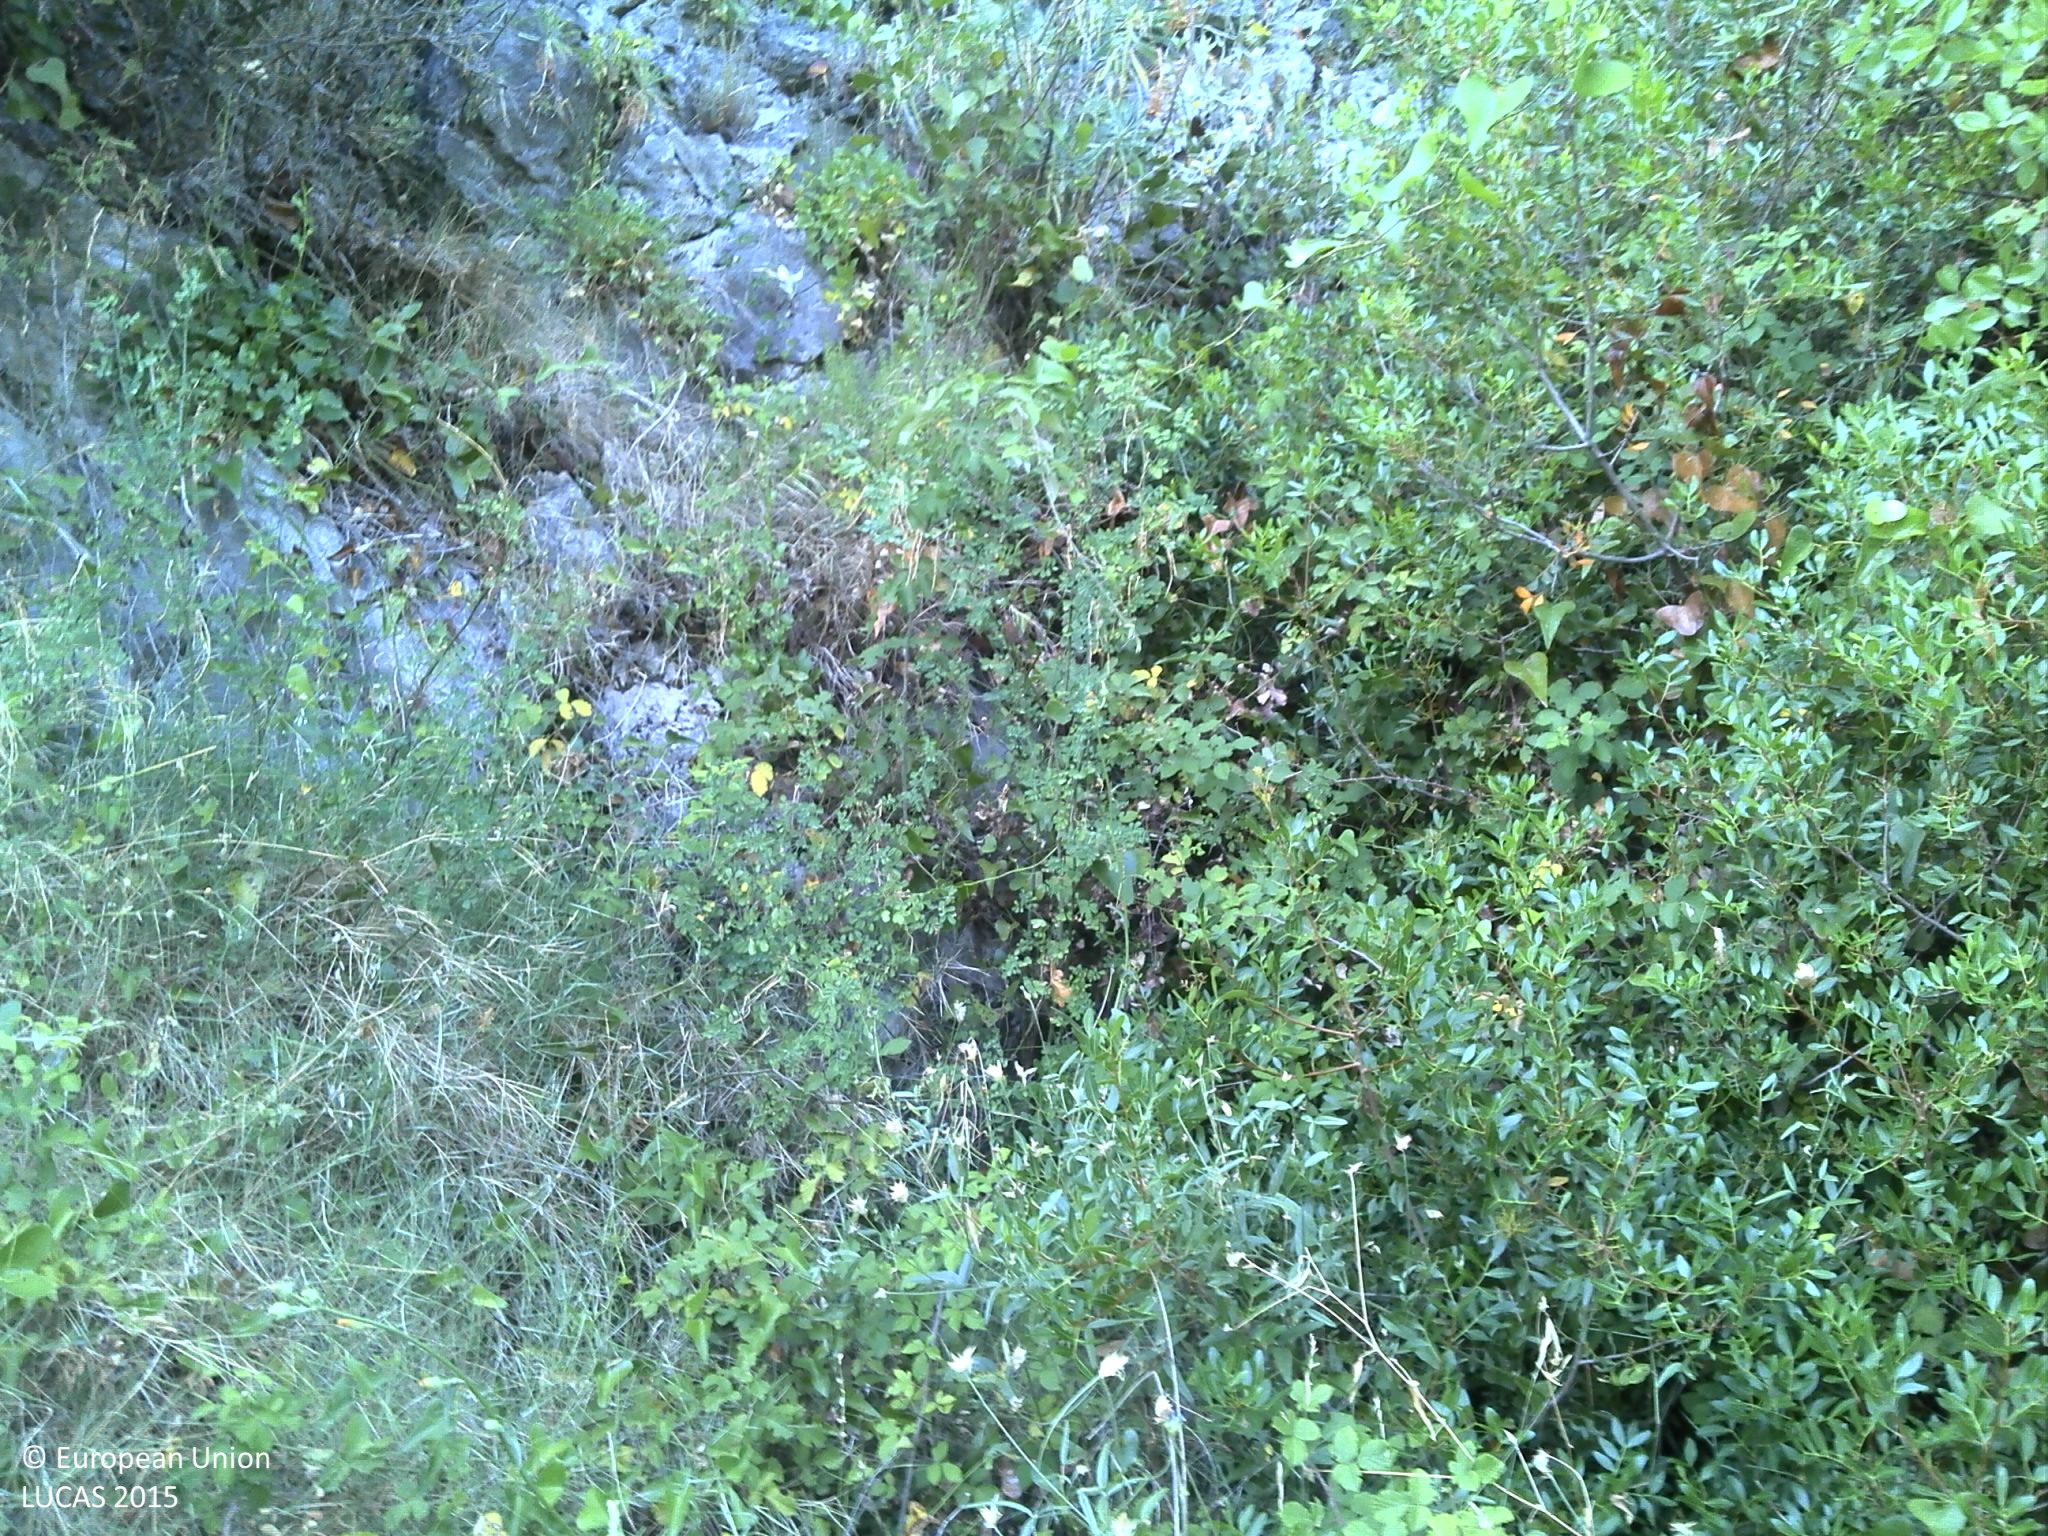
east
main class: Shrubland
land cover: Shrubland with sparse tree cover
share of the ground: 50 - 75 %
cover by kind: shrubs 60 %, herbaceous plants 15 %, unconsolidated bare surface 15 %, broadleaved forest trees 5 %, consolidated bare surface 5 %
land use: Semi-natural and natural areas not in use
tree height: < 5 m
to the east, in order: Shrubland with sparse tree cover; Dry stone walls; Olive groves; Spontaneously vegetated surfaces; Dry stone walls; Rock outcrops; Olive groves; Ditches and canals; Spontaneously vegetated surfaces; Ditches and canals; Shrubland with sparse tree cover
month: July
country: HR
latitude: 42.6298
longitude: 18.1968
